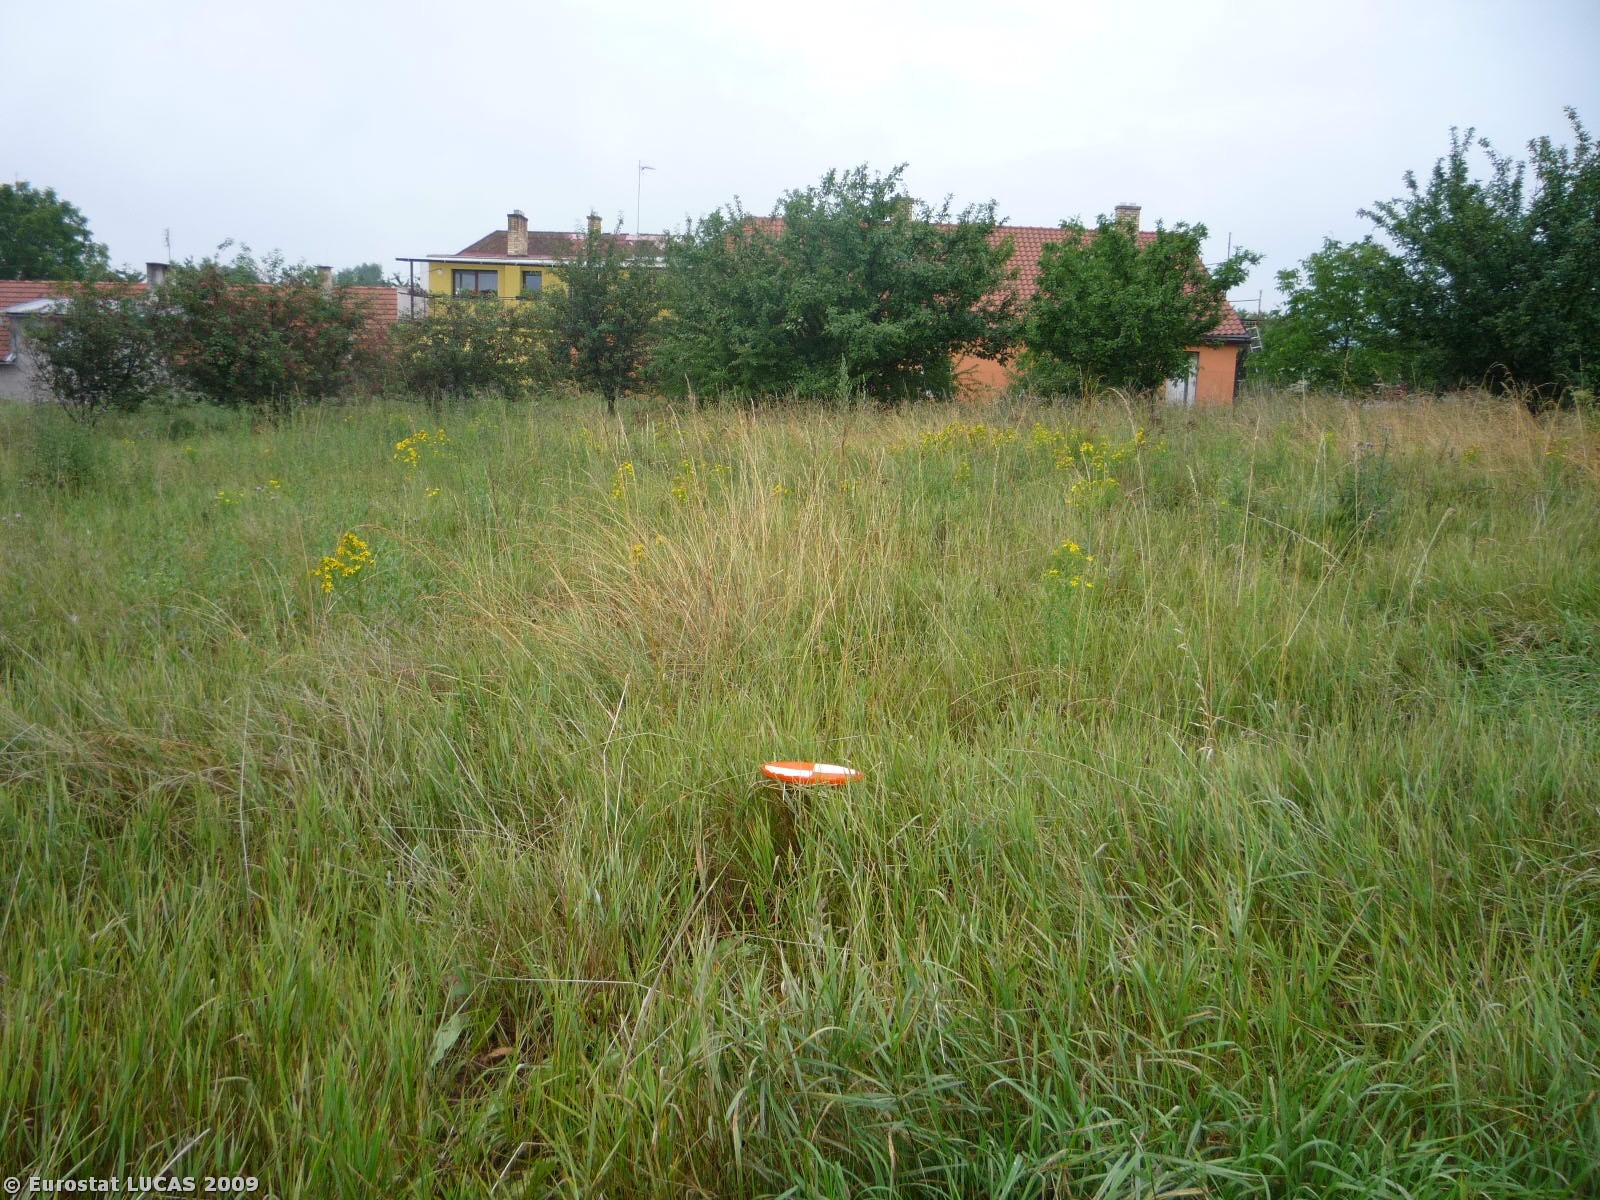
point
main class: Grassland
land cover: Grassland without tree/shrub cover
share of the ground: > 75 %
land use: Agriculture (excluding fallow land and kitchen gardens)
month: July
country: CZ
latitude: 49.9674
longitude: 14.9798
